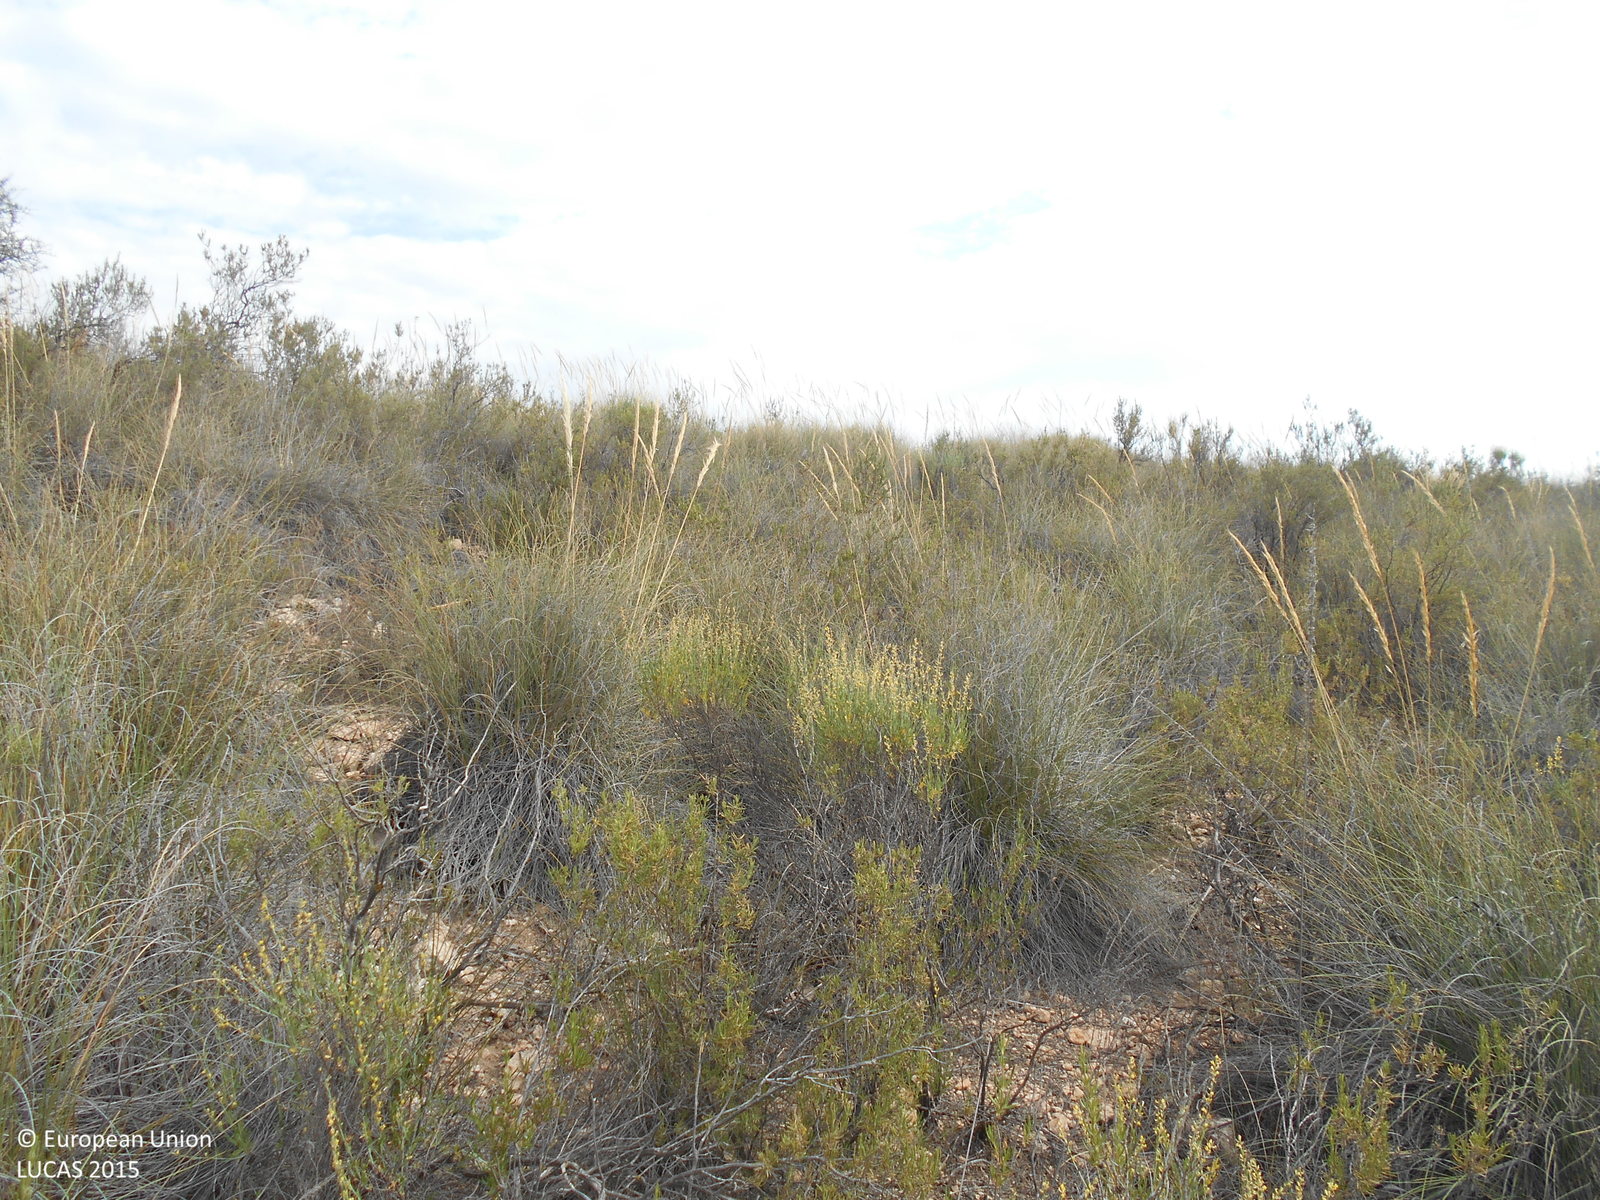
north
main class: Shrubland
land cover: Shrubland without tree cover
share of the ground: > 75 %
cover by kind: shrubs 90 %, unconsolidated bare surface 10 %
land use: Semi-natural and natural areas not in use
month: May
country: ES
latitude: 37.0713
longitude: -2.1805
